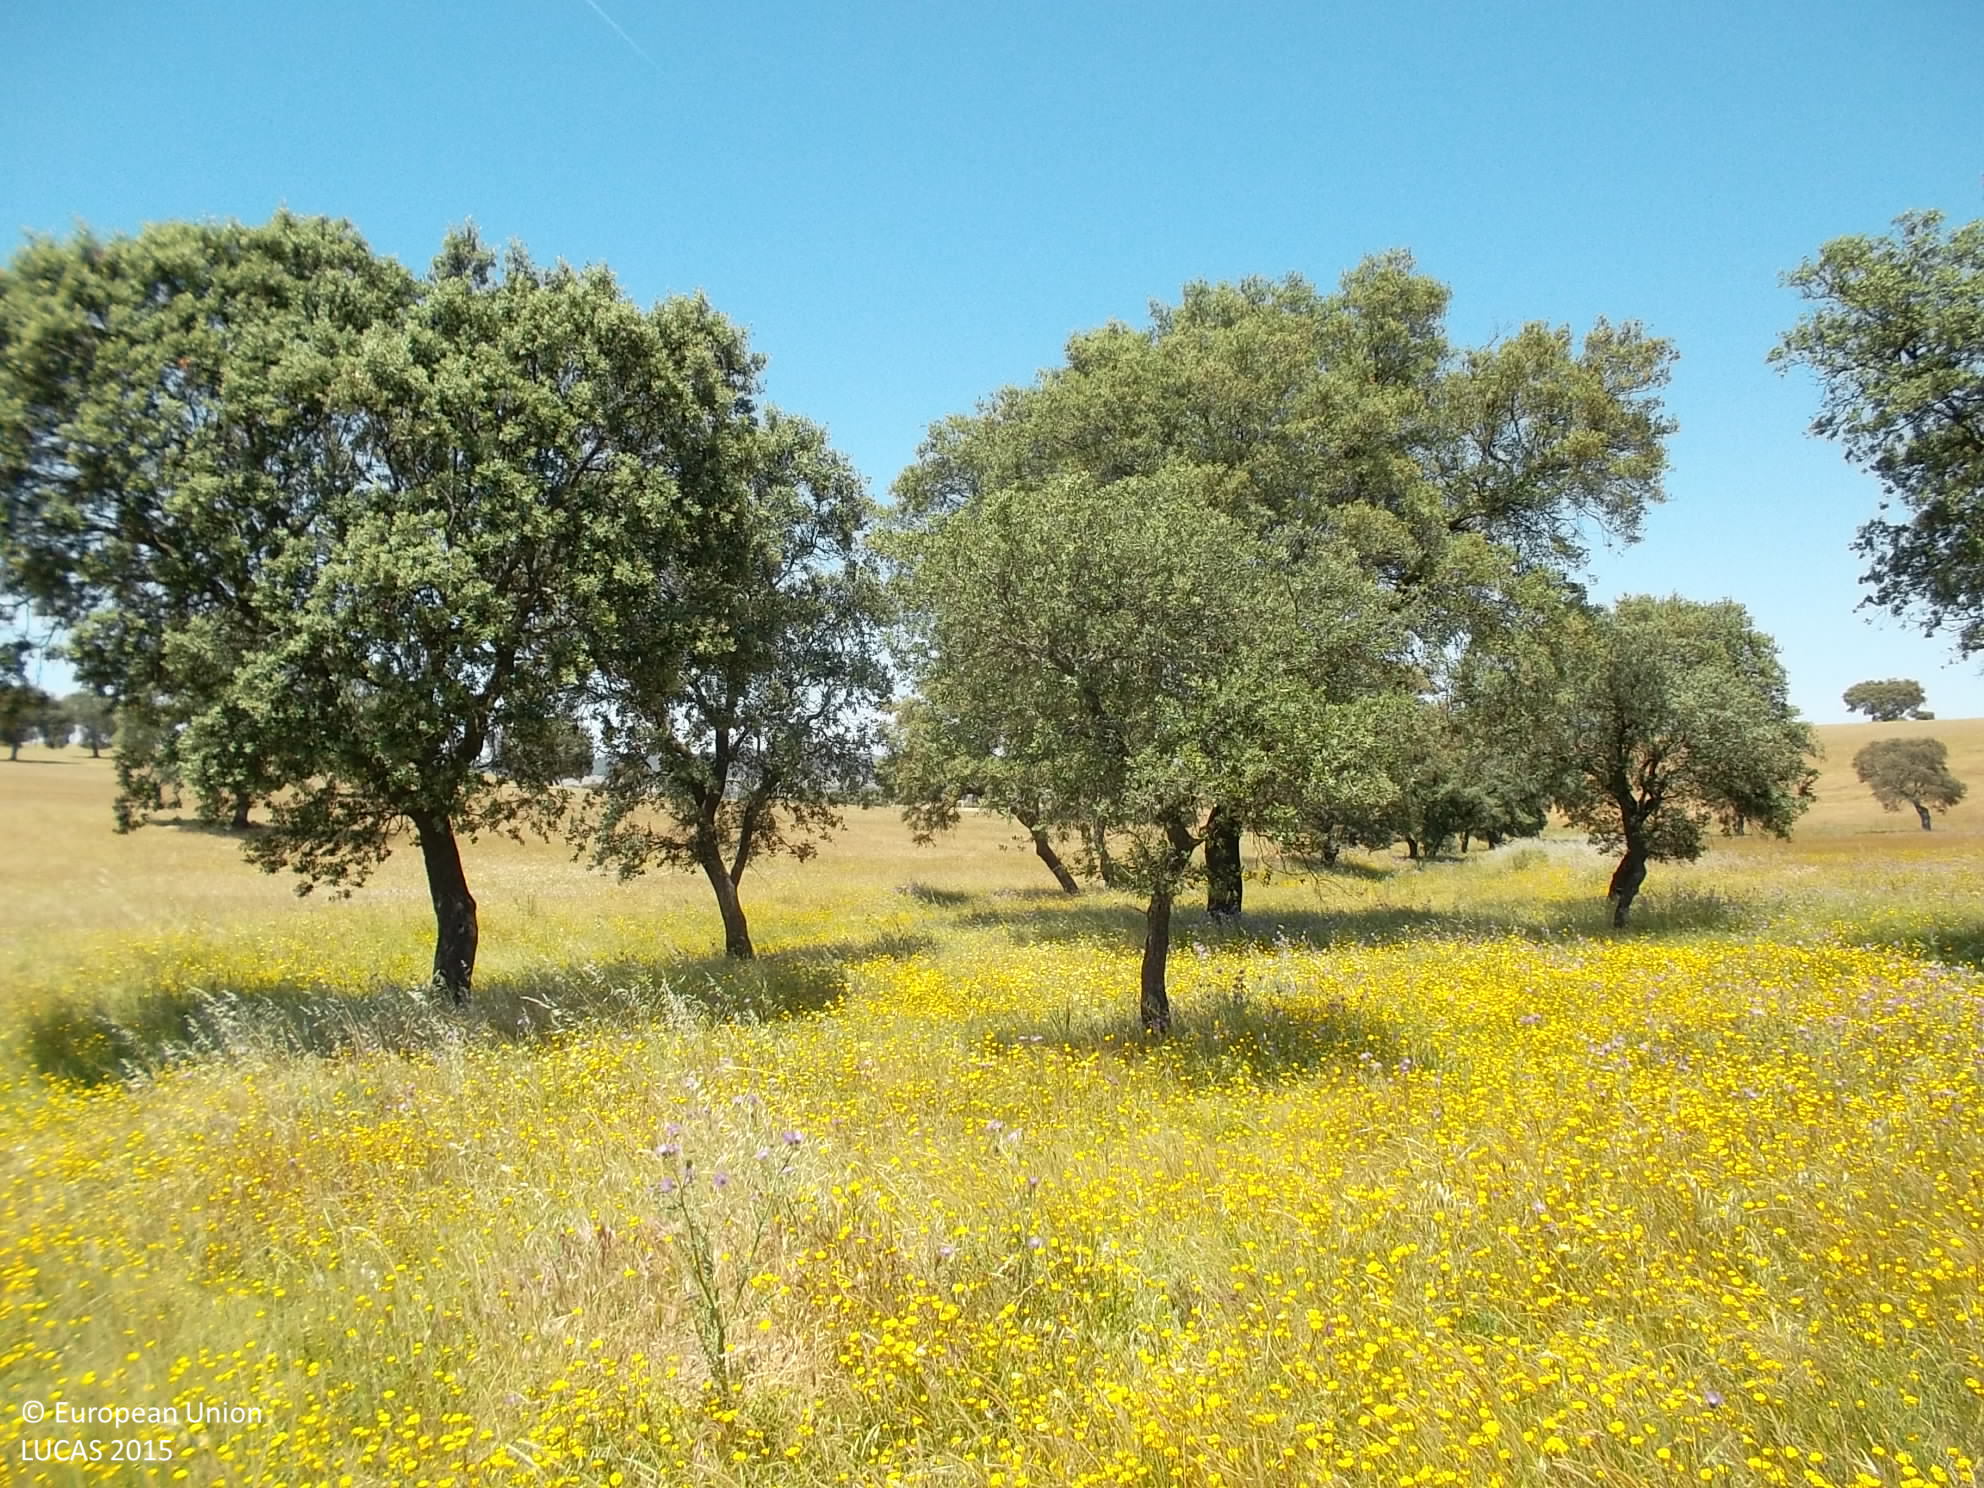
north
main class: Grassland
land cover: Grassland with sparse tree/shrub cover
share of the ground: > 75 %
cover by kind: herbaceous plants 95 %, broadleaved forest trees 5 %
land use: Agriculture (excluding fallow land and kitchen gardens)
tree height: > 5 m
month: May
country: ES
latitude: 38.8976
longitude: -4.4502
